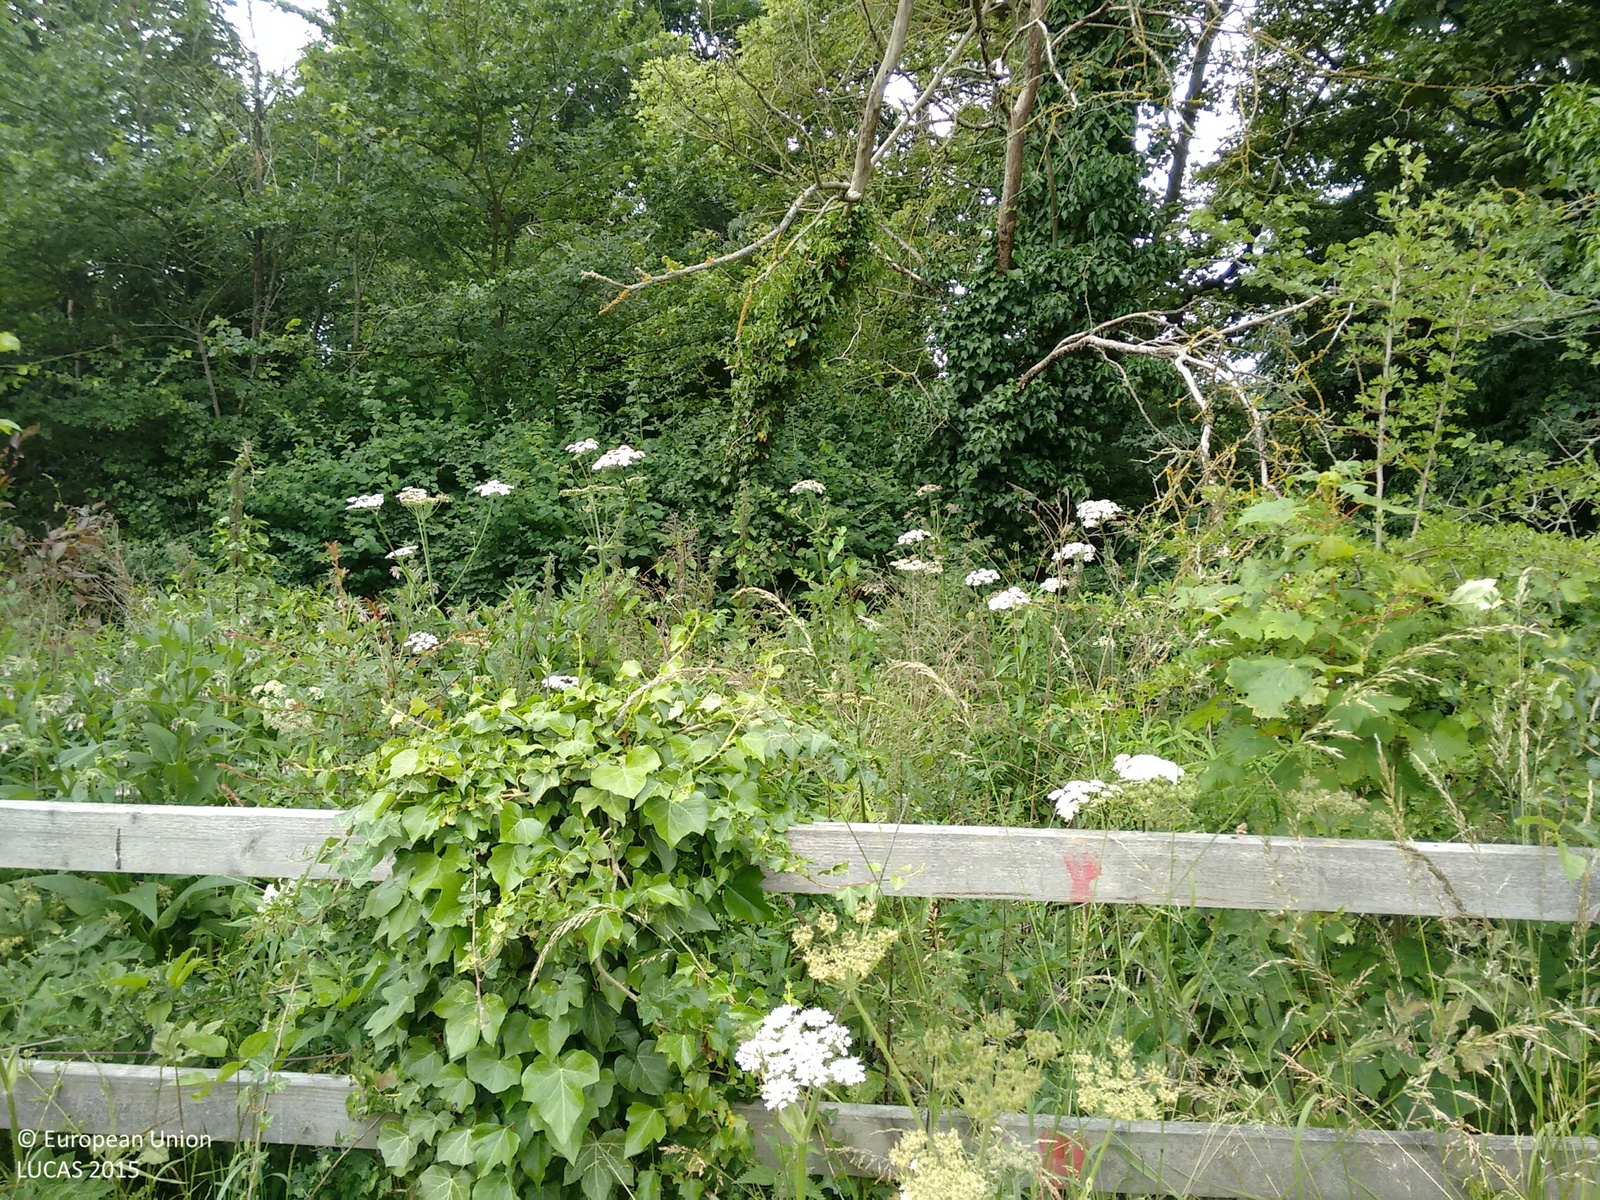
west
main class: Woodland
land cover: Broadleaved woodland
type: mesophytic deciduous forest
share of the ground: > 75 %
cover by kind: broadleaved forest trees 60 %, herbaceous plants 40 %
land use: Semi-natural and natural areas not in use
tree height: > 5 m
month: June
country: GB
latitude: 51.6386
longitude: -1.2753
